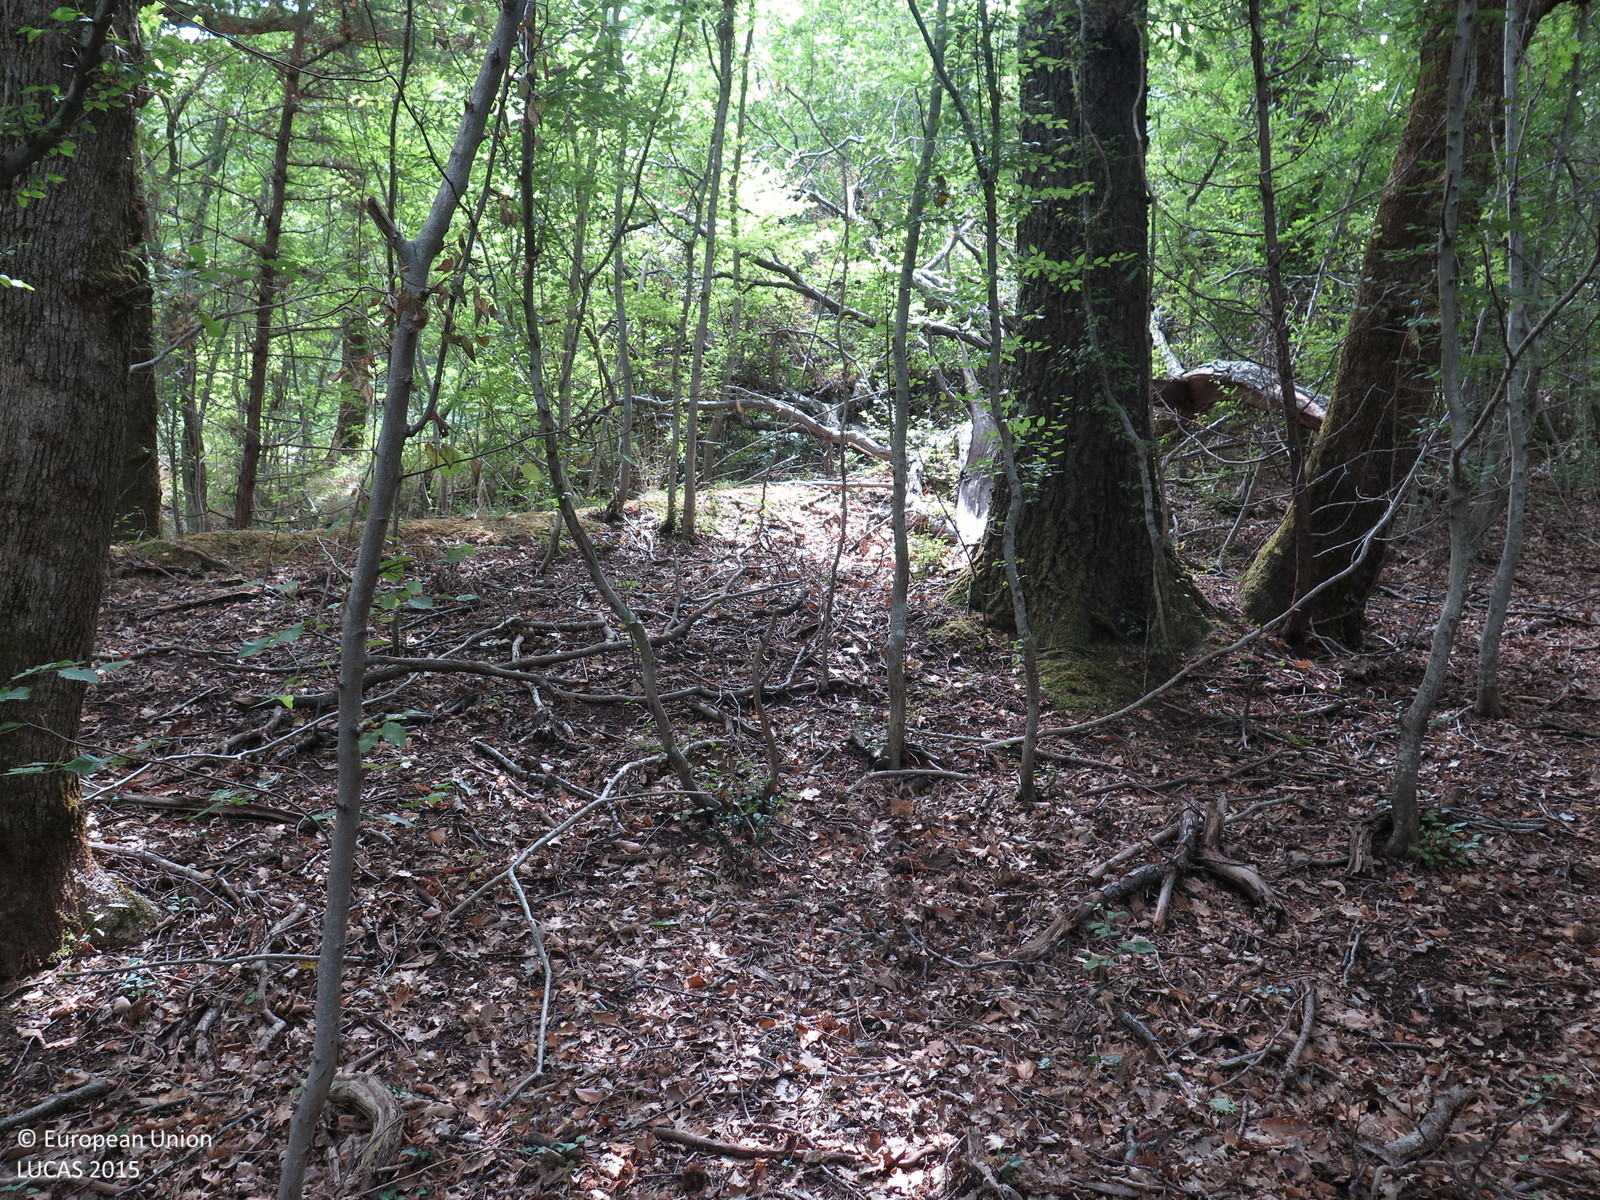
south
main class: Woodland
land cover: Broadleaved woodland
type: beech forest
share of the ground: > 75 %
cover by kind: broadleaved forest trees 100 %
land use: Forestry
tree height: > 5 m
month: August
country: HR
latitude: 45.1521
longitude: 14.5863
